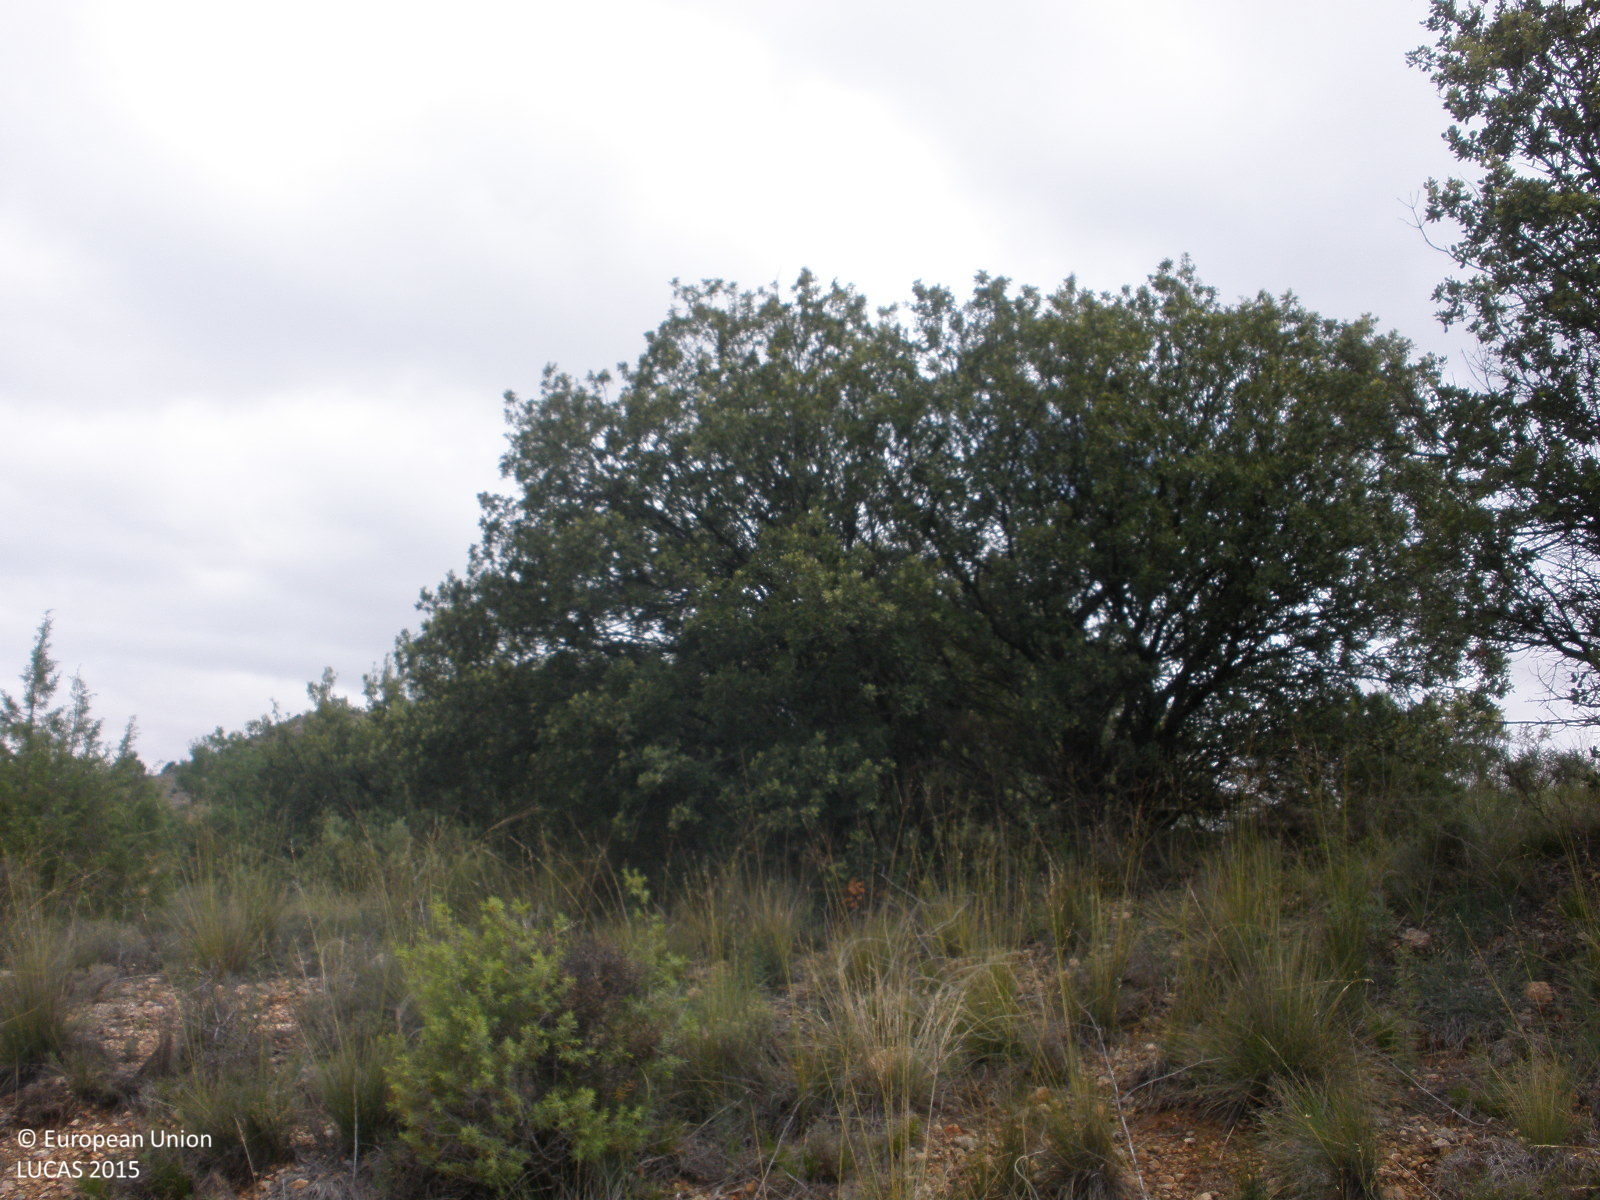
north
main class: Woodland
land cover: Other mixed woodland
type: coniferous forest of the mediterranean region
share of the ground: 25 - 50 %
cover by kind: shrubs 30 %, coniferous forest trees 20 %, broadleaved forest trees 20 %, consolidated bare surface 20 %, herbaceous plants 10 %
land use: Semi-natural and natural areas not in use
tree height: < 5 m
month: June
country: ES
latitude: 40.4660
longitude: -1.0149
